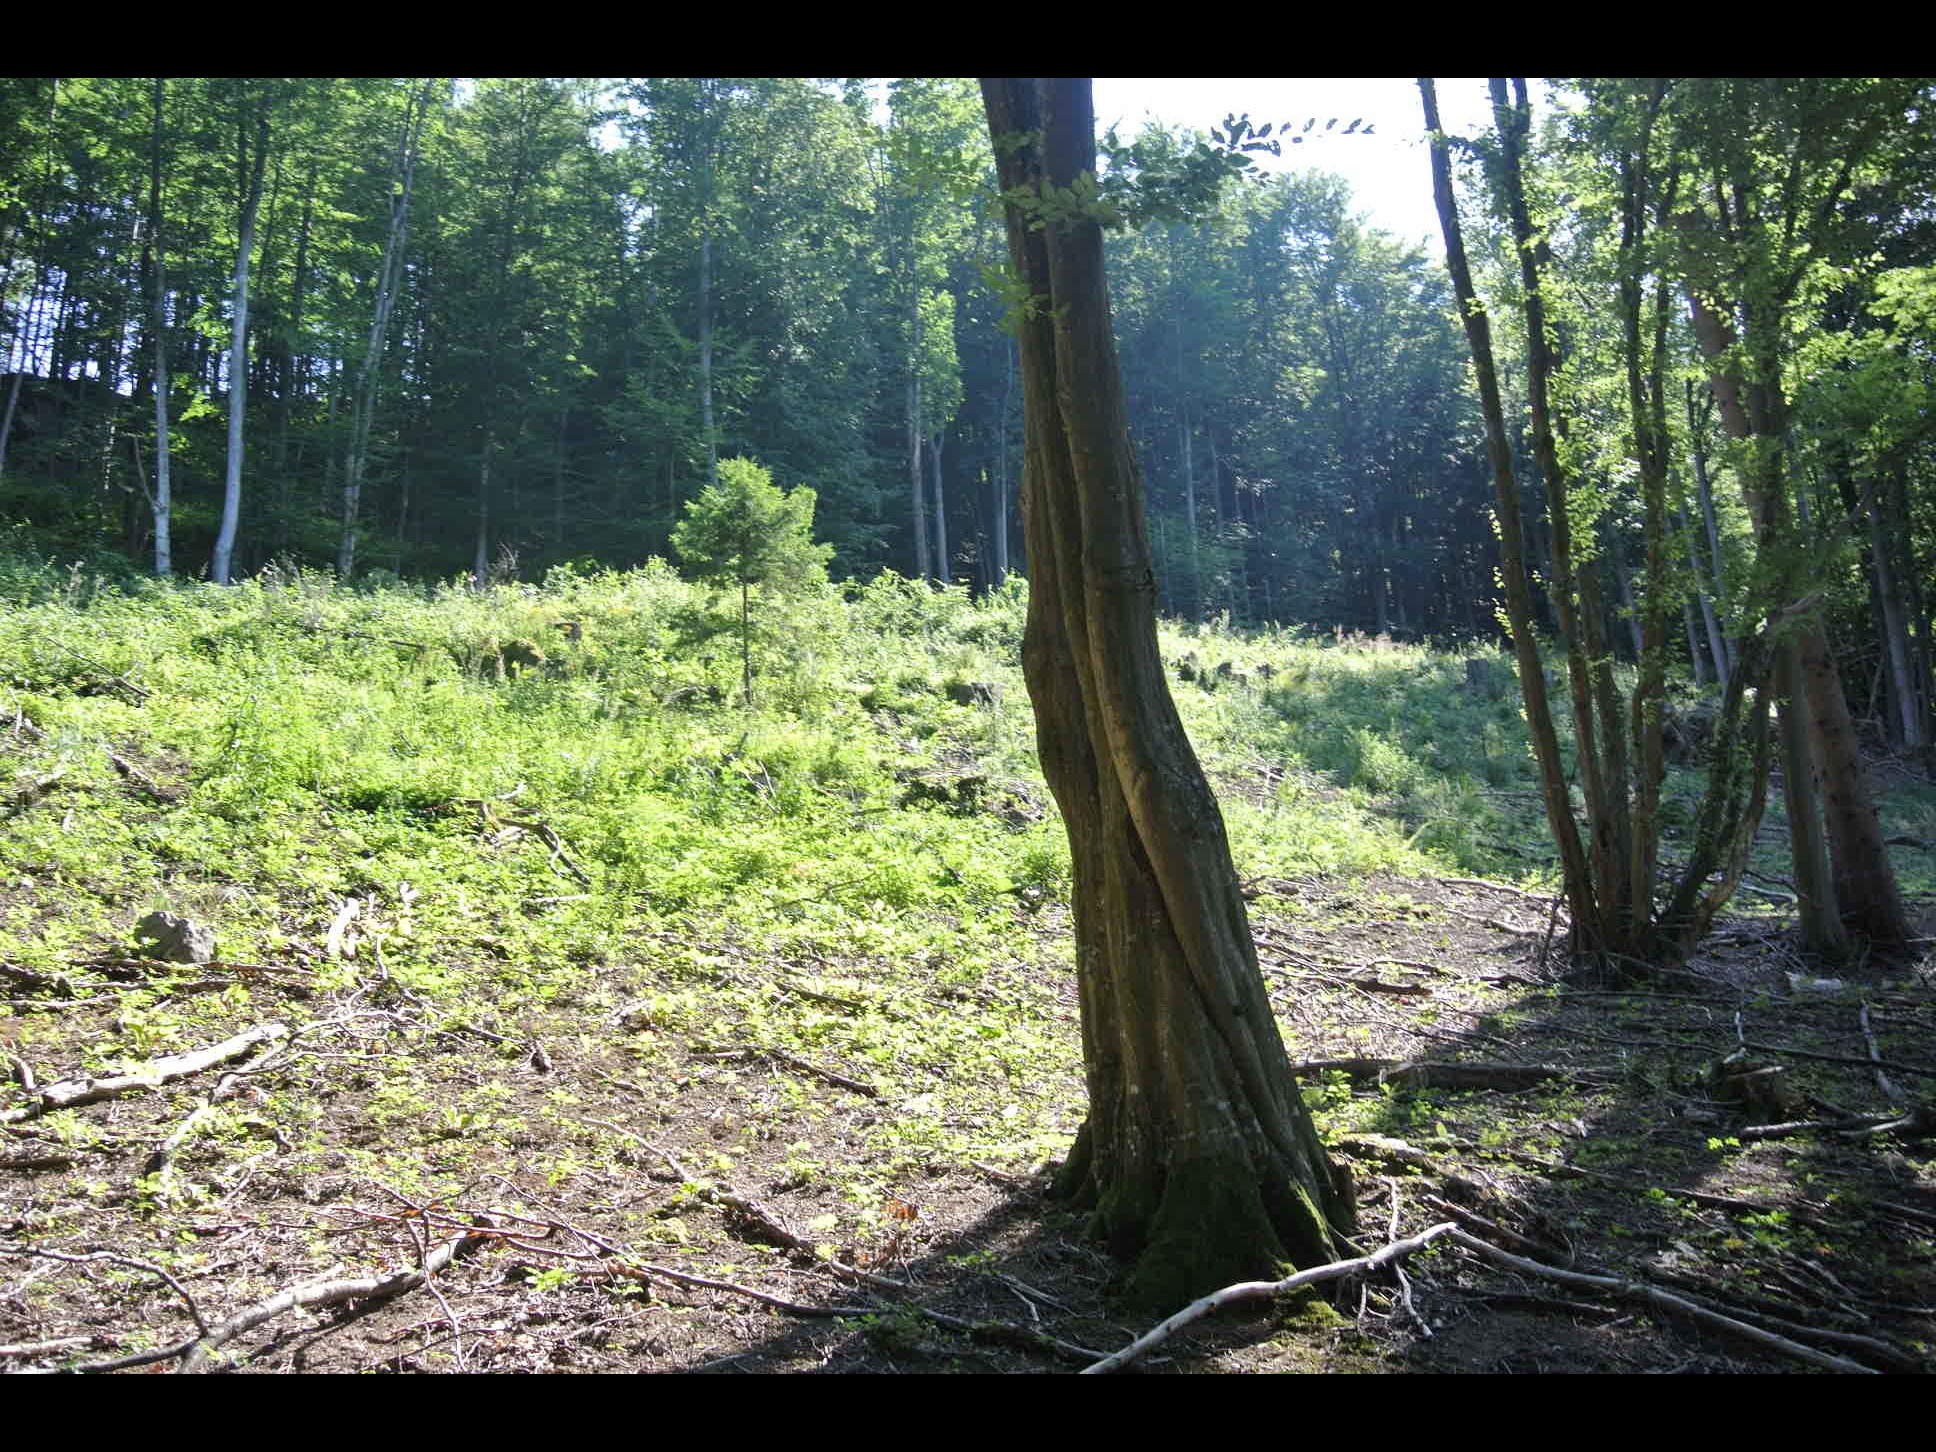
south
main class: Woodland
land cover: Broadleaved woodland
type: alpine coniferous forest
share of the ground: > 75 %
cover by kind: broadleaved forest trees 90 %, unconsolidated bare surface 10 %
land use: Forestry
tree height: > 5 m
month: July
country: AT
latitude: 47.9929
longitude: 15.5634
